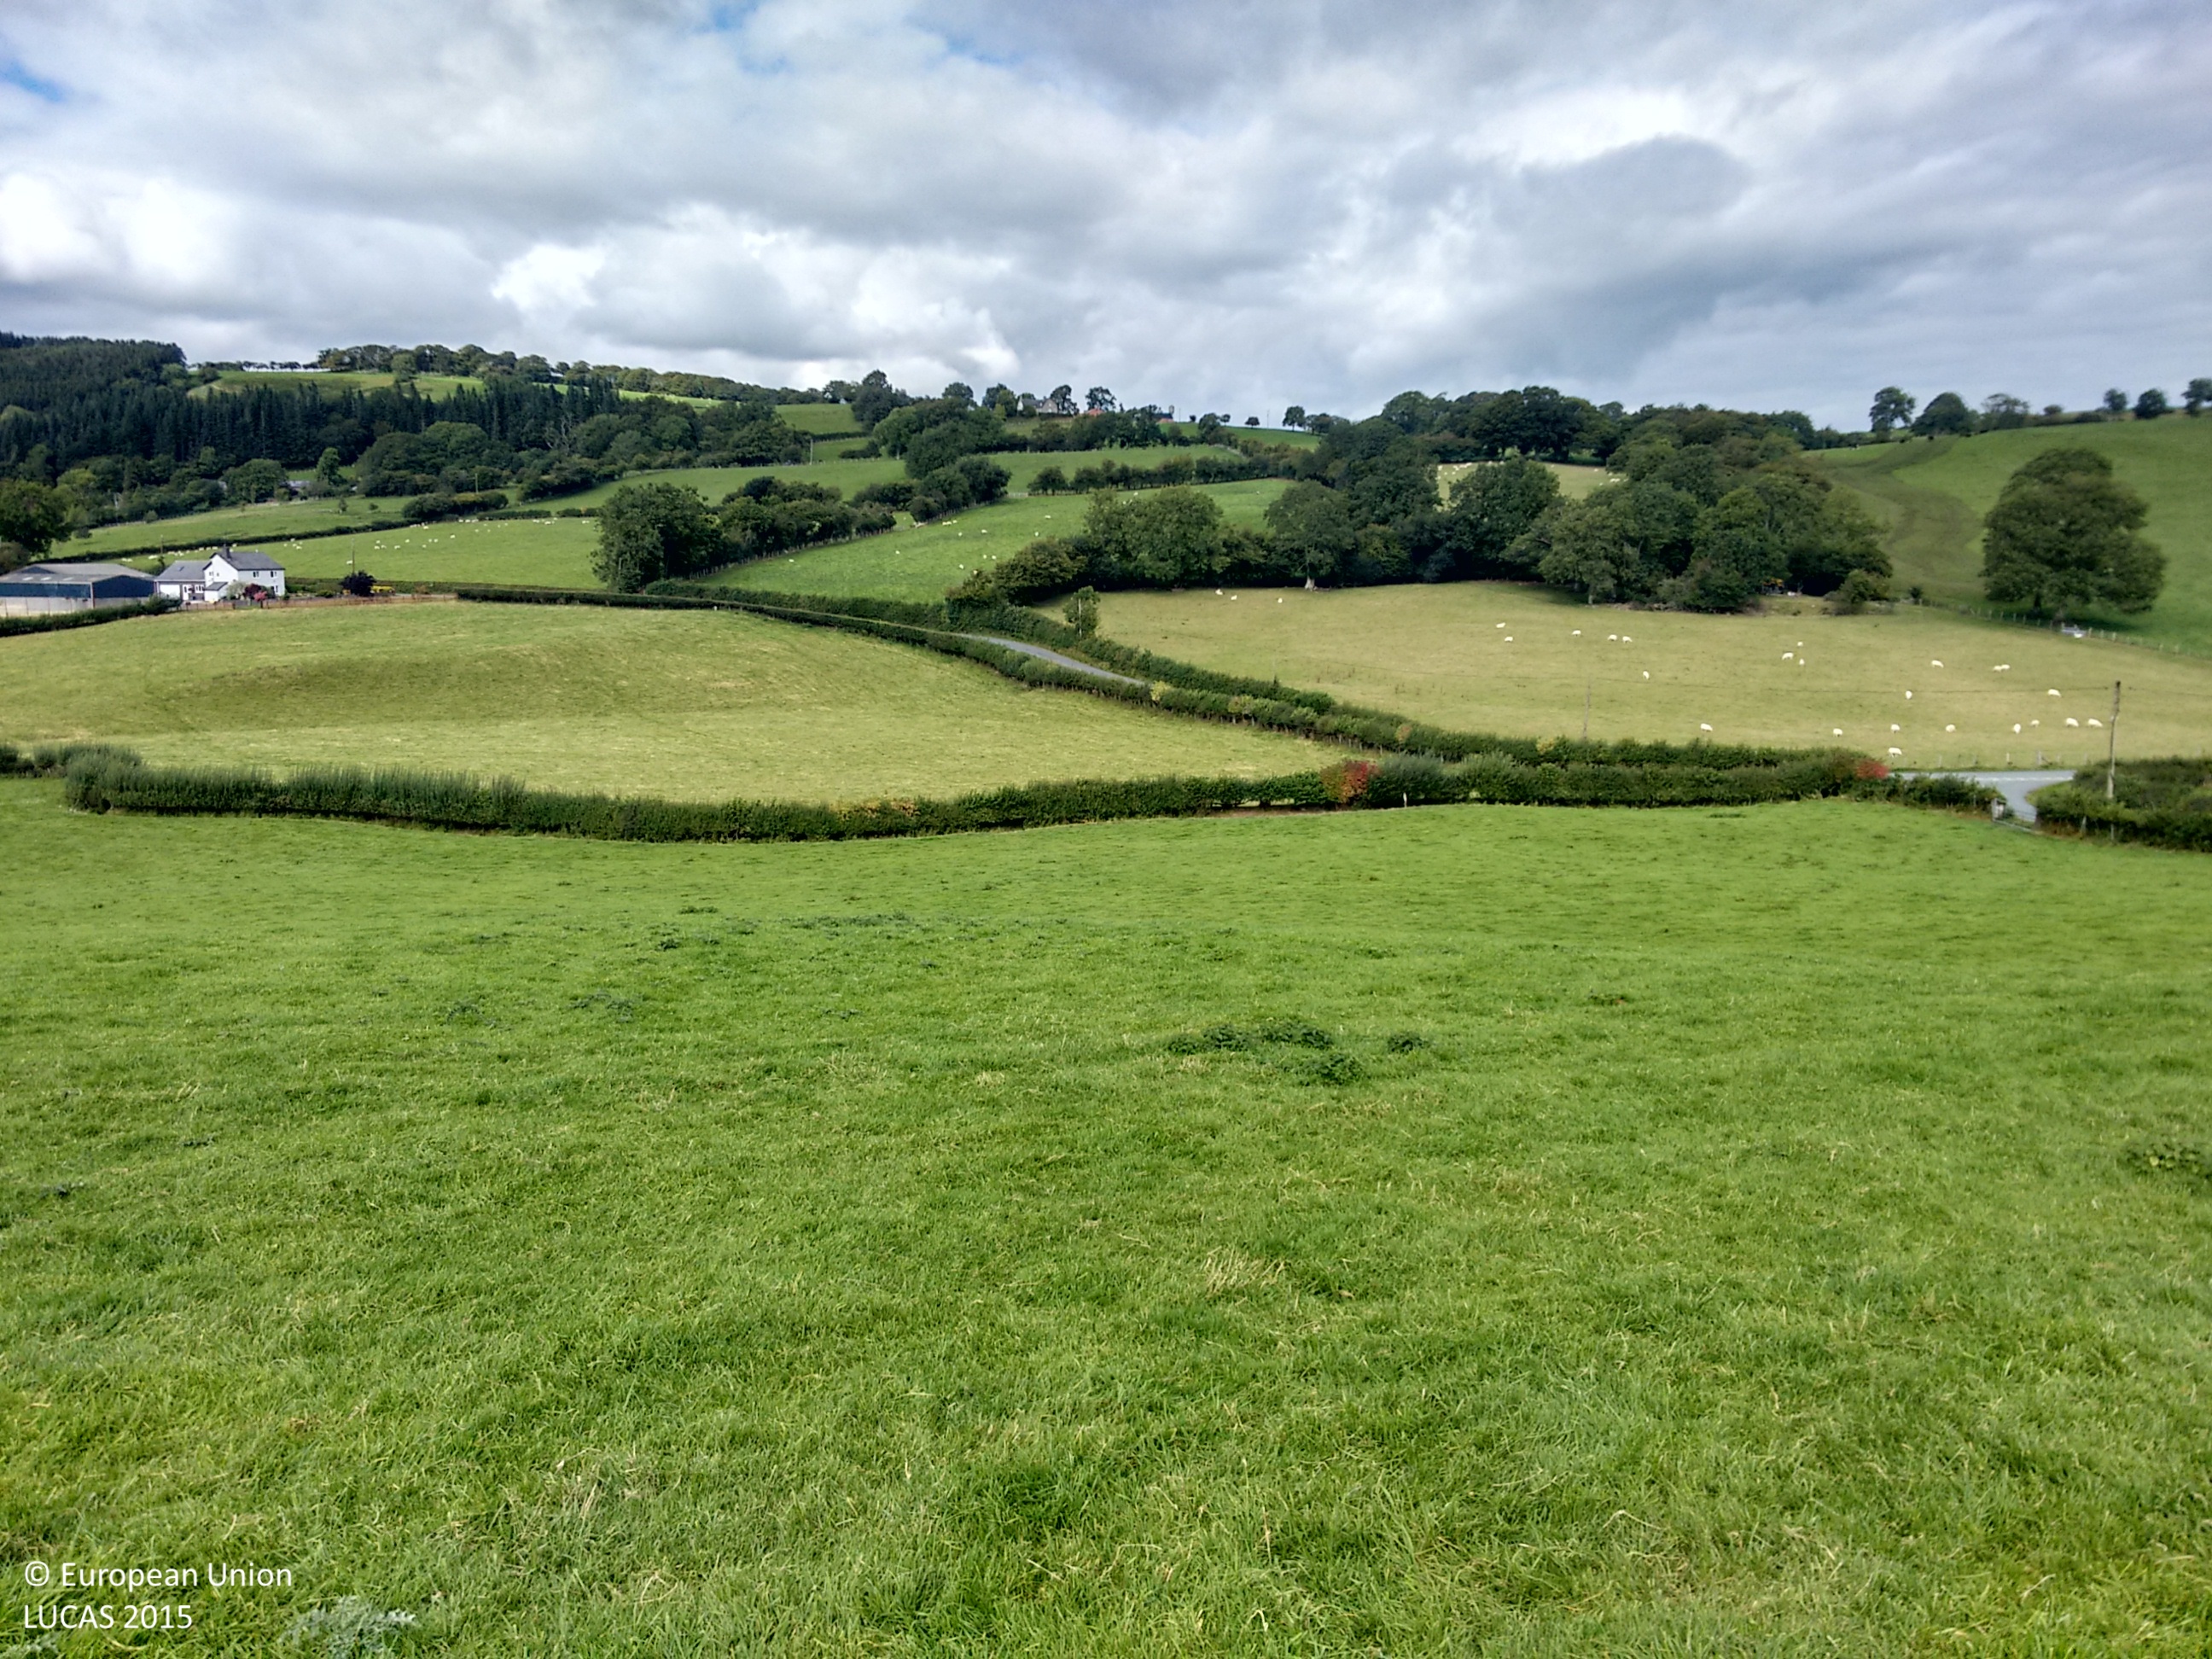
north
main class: Grassland
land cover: Grassland without tree/shrub cover
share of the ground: > 75 %
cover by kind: herbaceous plants 100 %
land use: Agriculture (excluding fallow land and kitchen gardens)
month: September
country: GB
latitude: 52.6944
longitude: -3.3537
